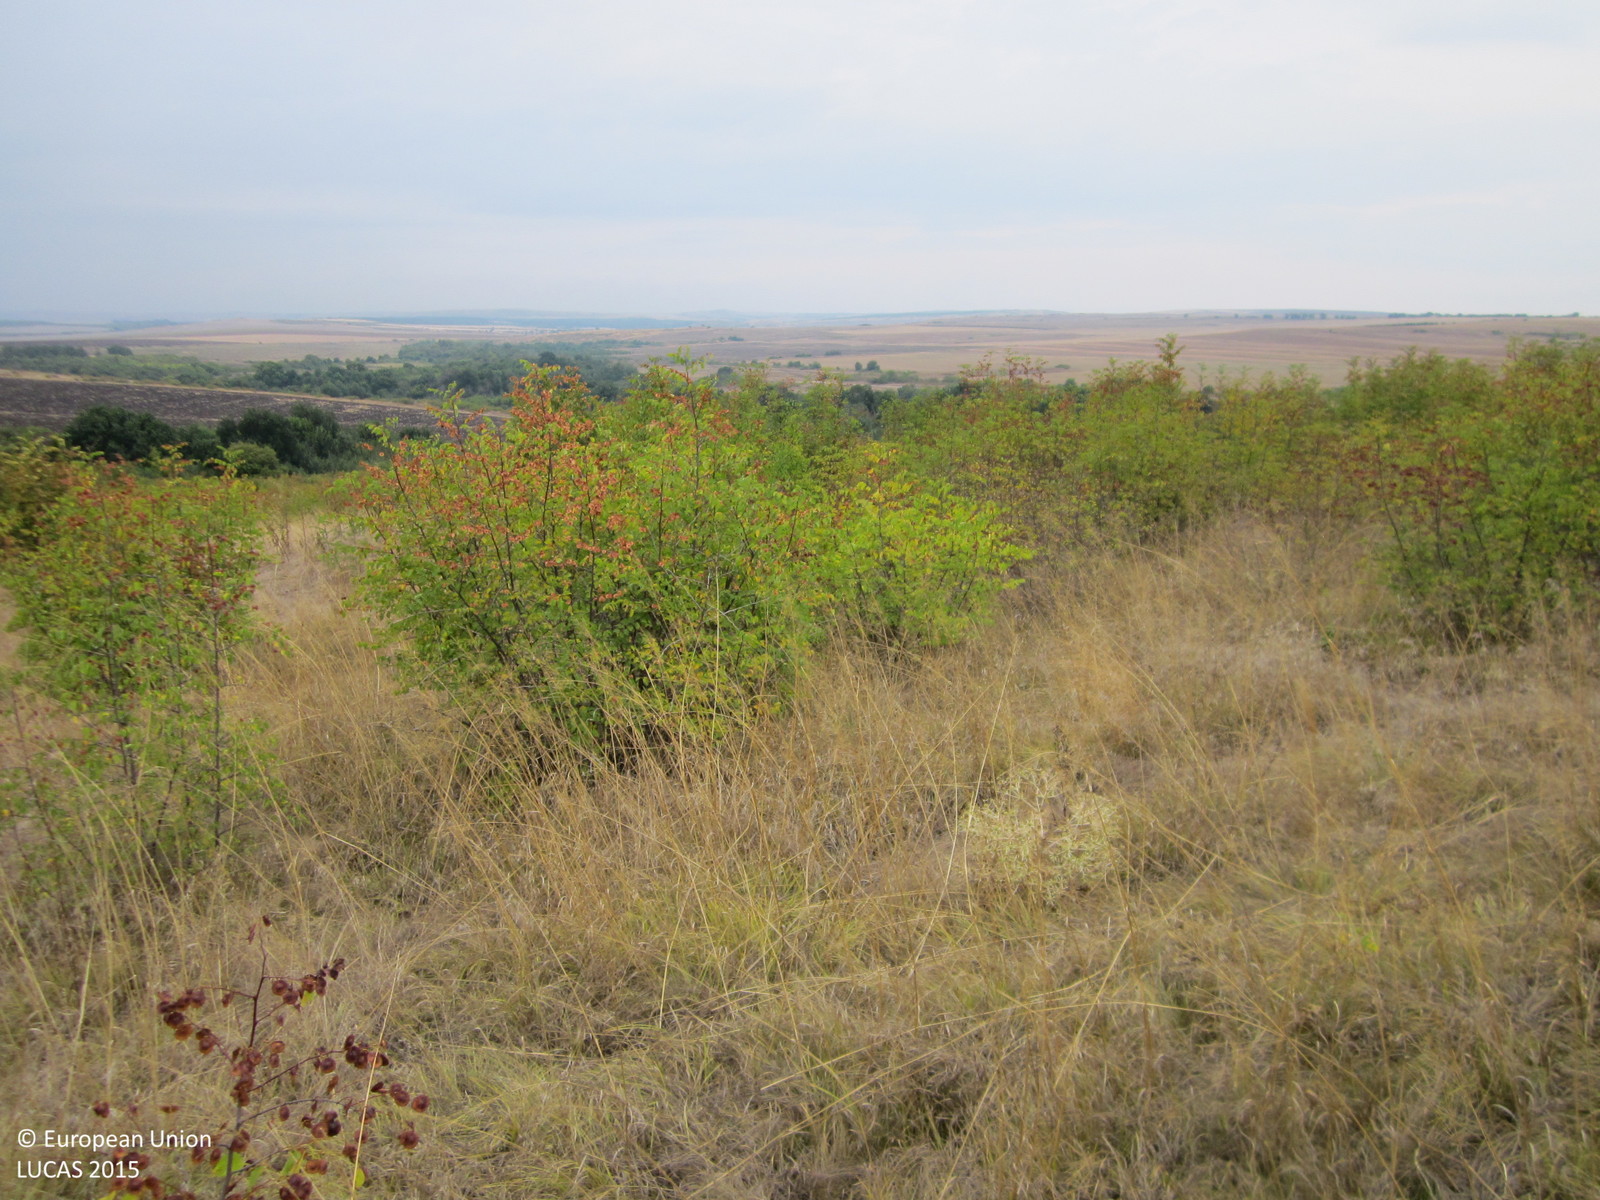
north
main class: Shrubland
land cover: Shrubland without tree cover
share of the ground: 50 - 75 %
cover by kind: shrubs 60 %, herbaceous plants 40 %
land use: Semi-natural and natural areas not in use
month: August
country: BG
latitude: 42.5237
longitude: 27.0388
